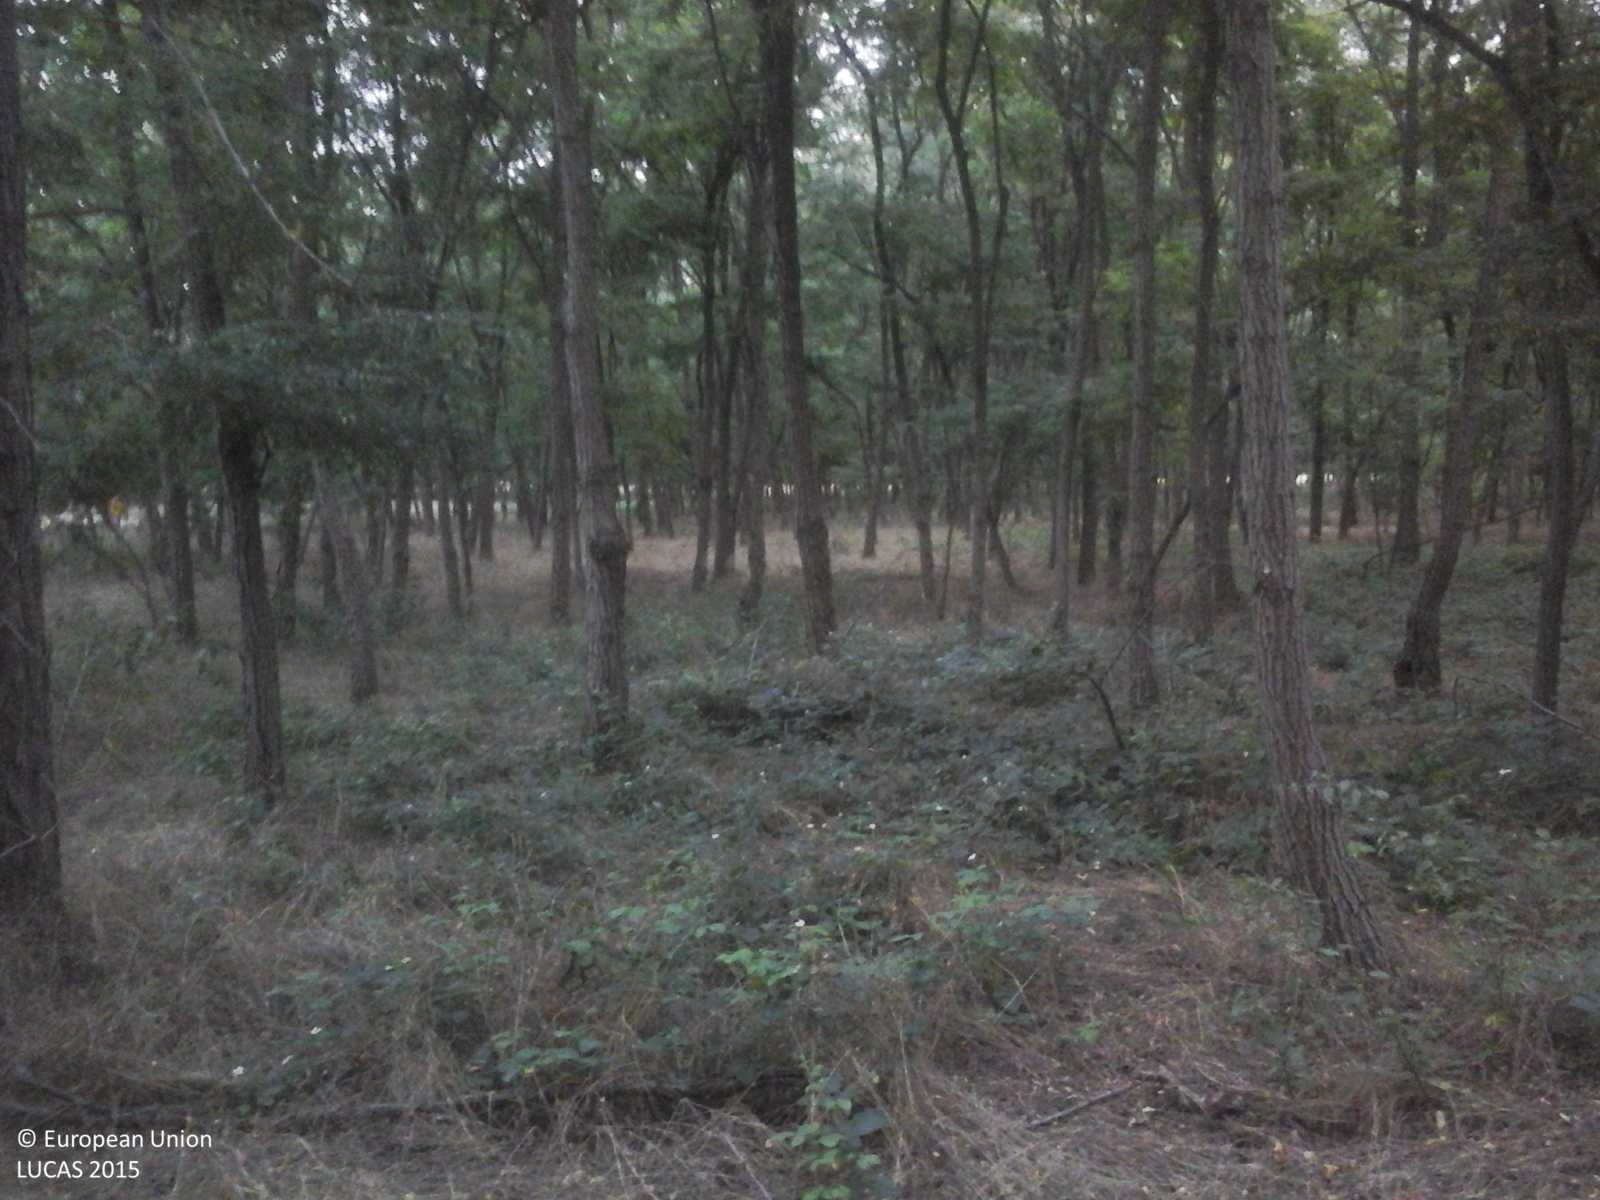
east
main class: Woodland
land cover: Broadleaved woodland
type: exotic forest
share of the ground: > 75 %
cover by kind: broadleaved forest trees 85 %, herbaceous plants 15 %
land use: Forestry
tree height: > 5 m
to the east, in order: Broadleaved woodland; Grassland with sparse tree/shrub cover; Broadleaved woodland
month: July
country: RO
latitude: 43.8470
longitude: 24.1773
